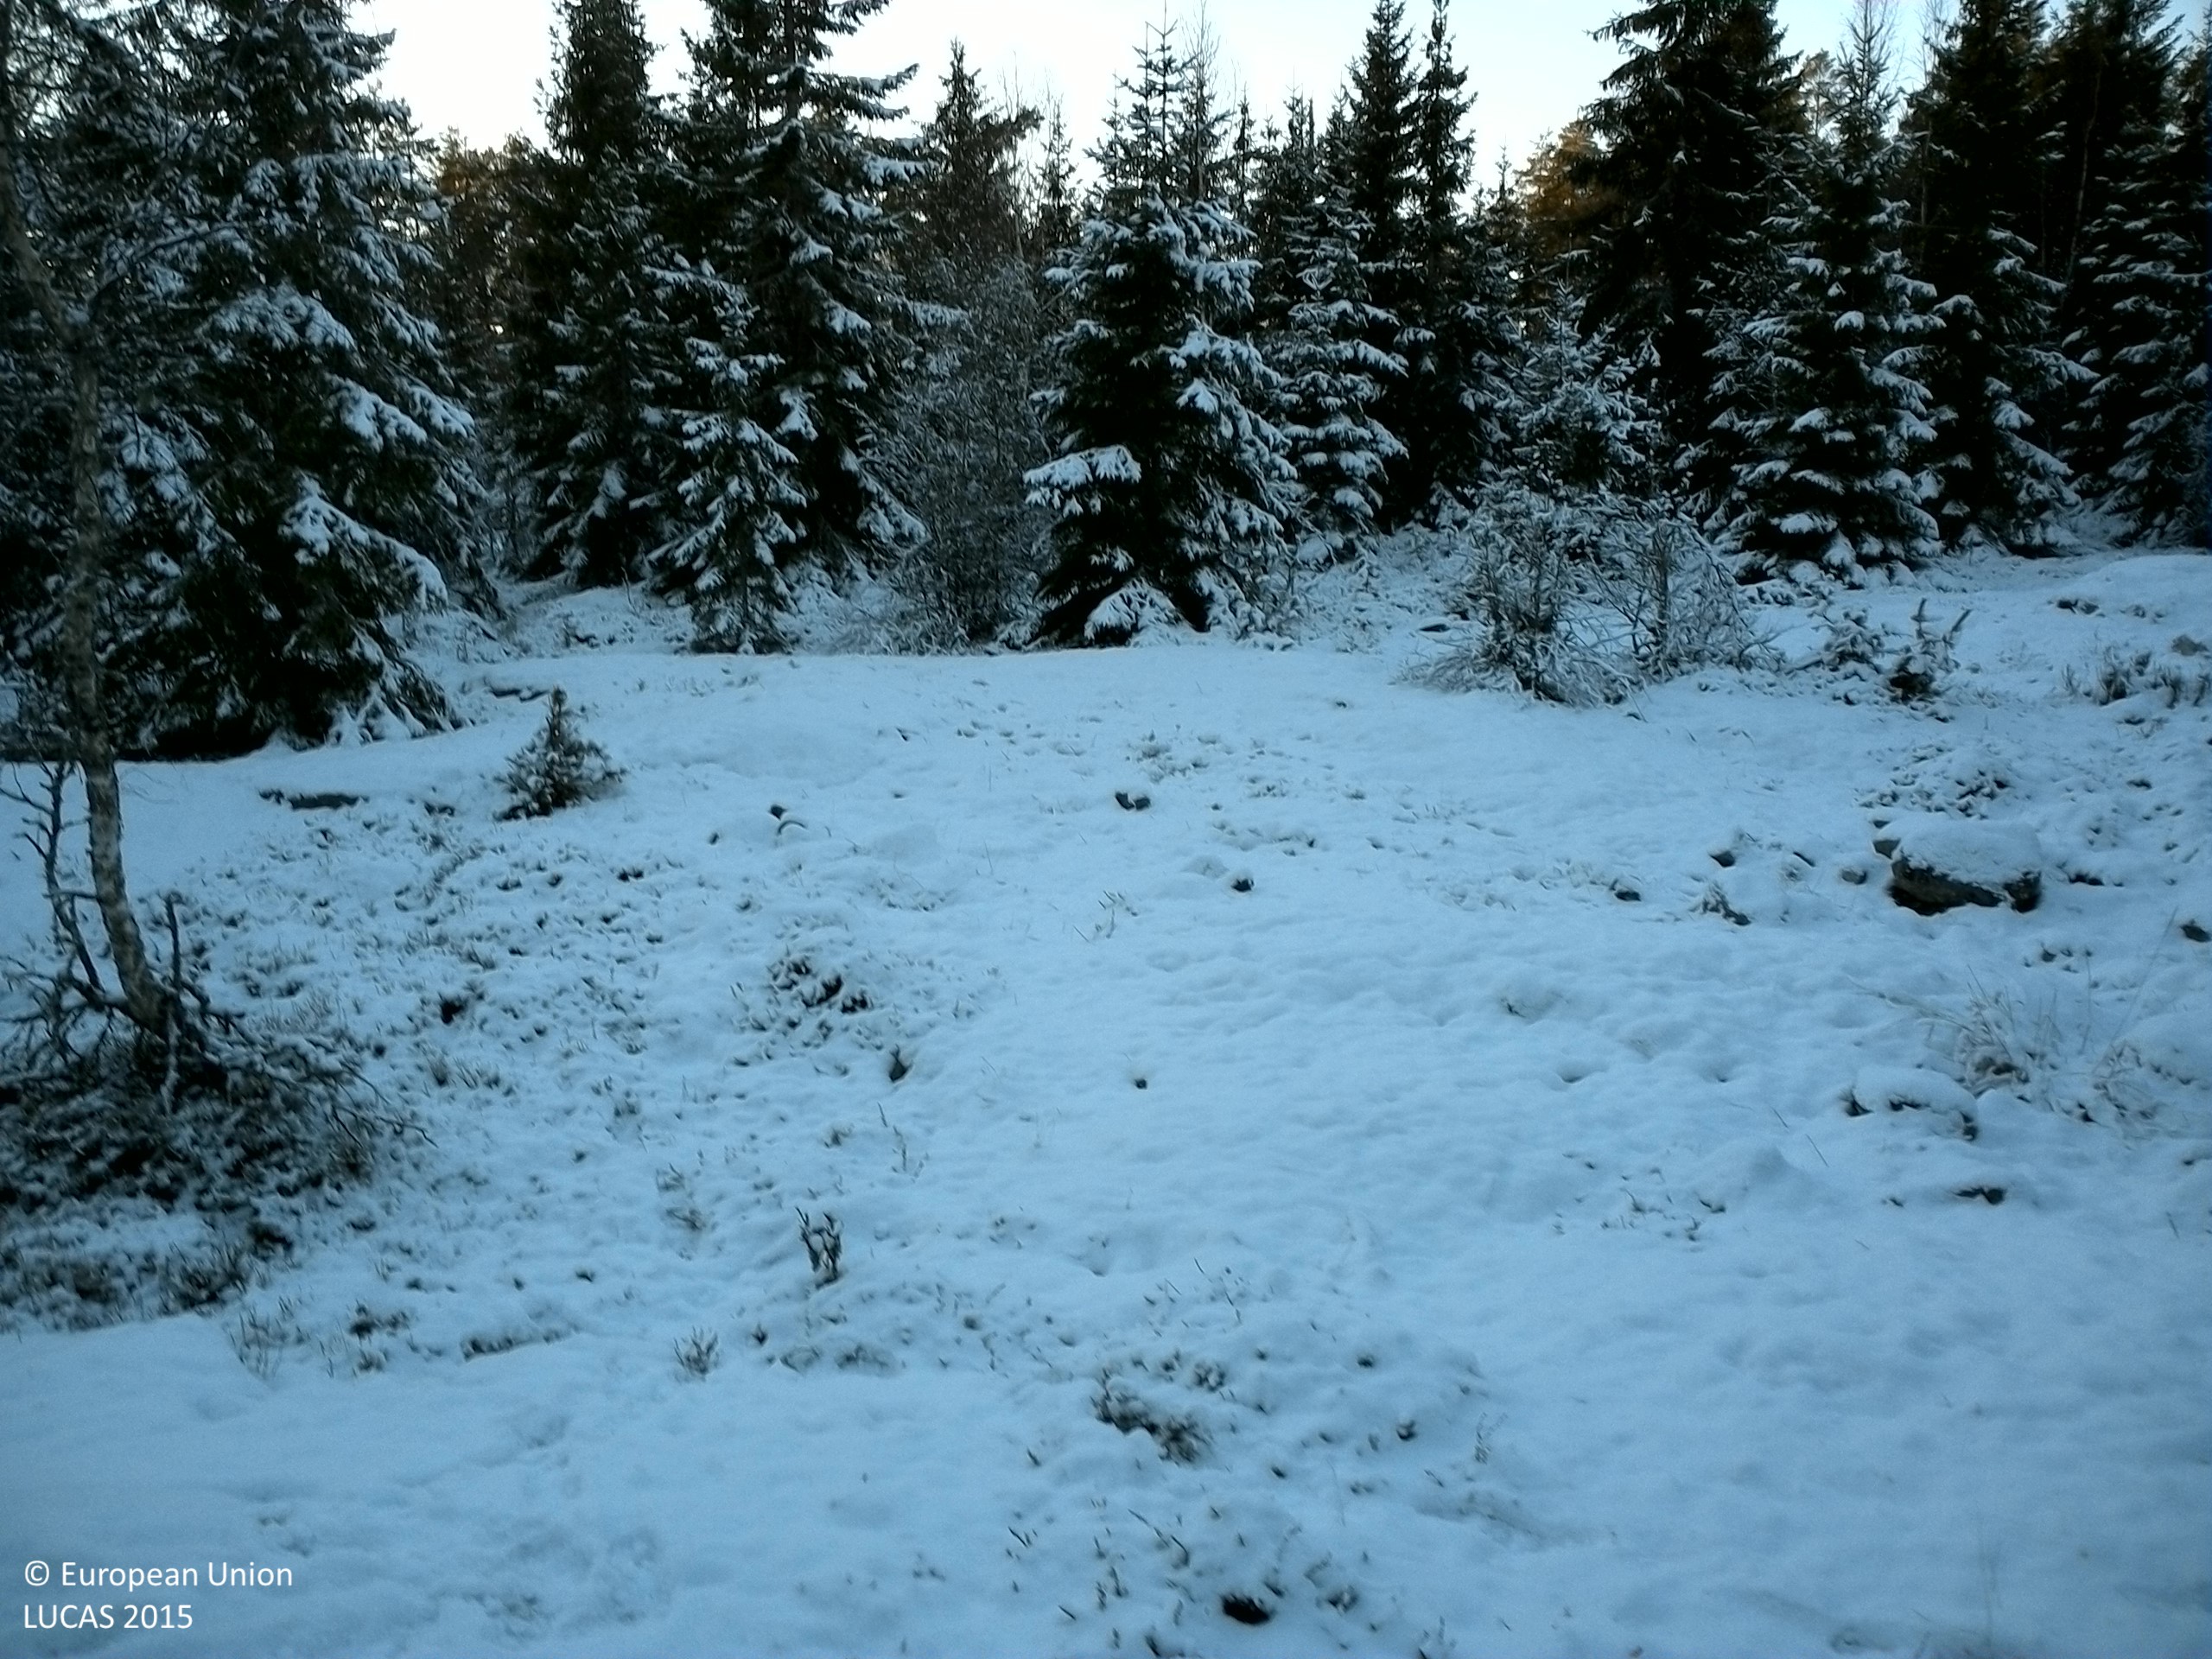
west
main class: Woodland
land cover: Spruce dominated mixed woodland
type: boreal forest
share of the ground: 50 - 75 %
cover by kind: coniferous forest trees 40 %, consolidated bare surface 20 %, broadleaved forest trees 15 %, shrubs 15 %, herbaceous plants 5 %, lichens and mosses 5 %
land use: Semi-natural and natural areas not in use
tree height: > 5 m
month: December
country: SE
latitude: 59.6414
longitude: 16.3243
